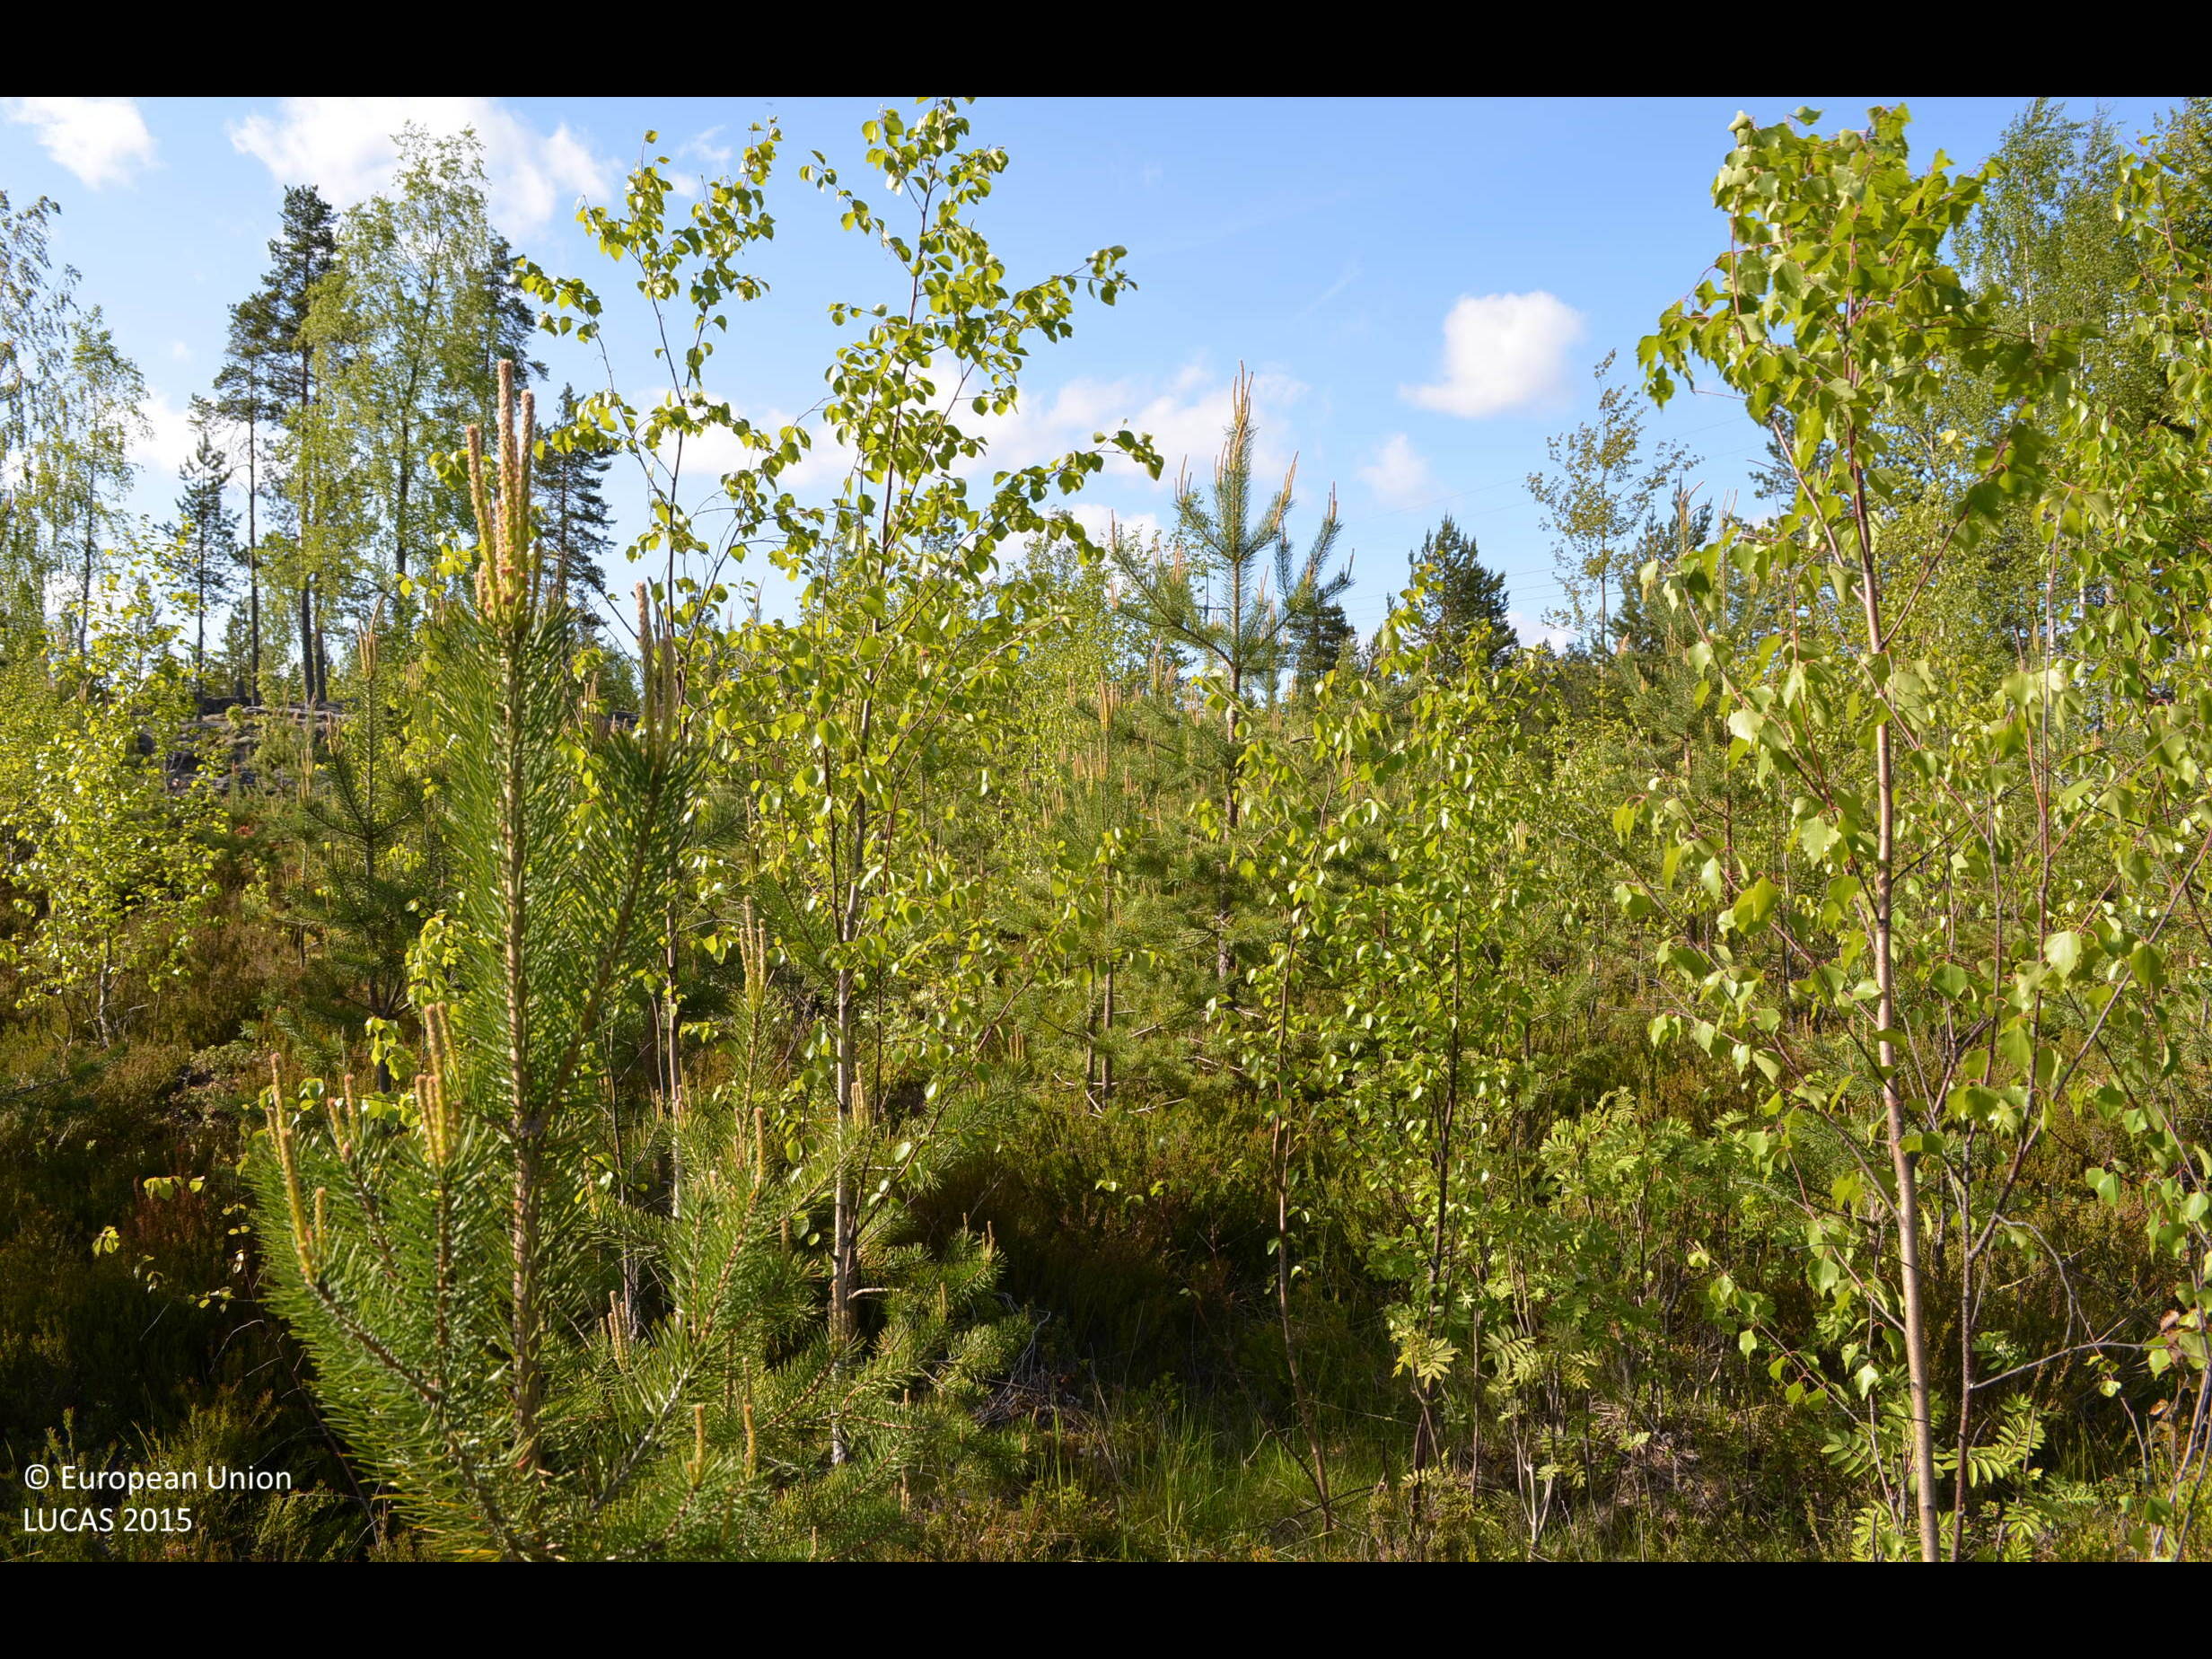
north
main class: Woodland
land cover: Pine dominated mixed woodland
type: boreal forest
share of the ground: 50 - 75 %
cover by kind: shrubs 50 %, coniferous forest trees 25 %, broadleaved forest trees 25 %
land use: Forestry
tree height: < 5 m
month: June
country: FI
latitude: 61.8558
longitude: 23.2806
